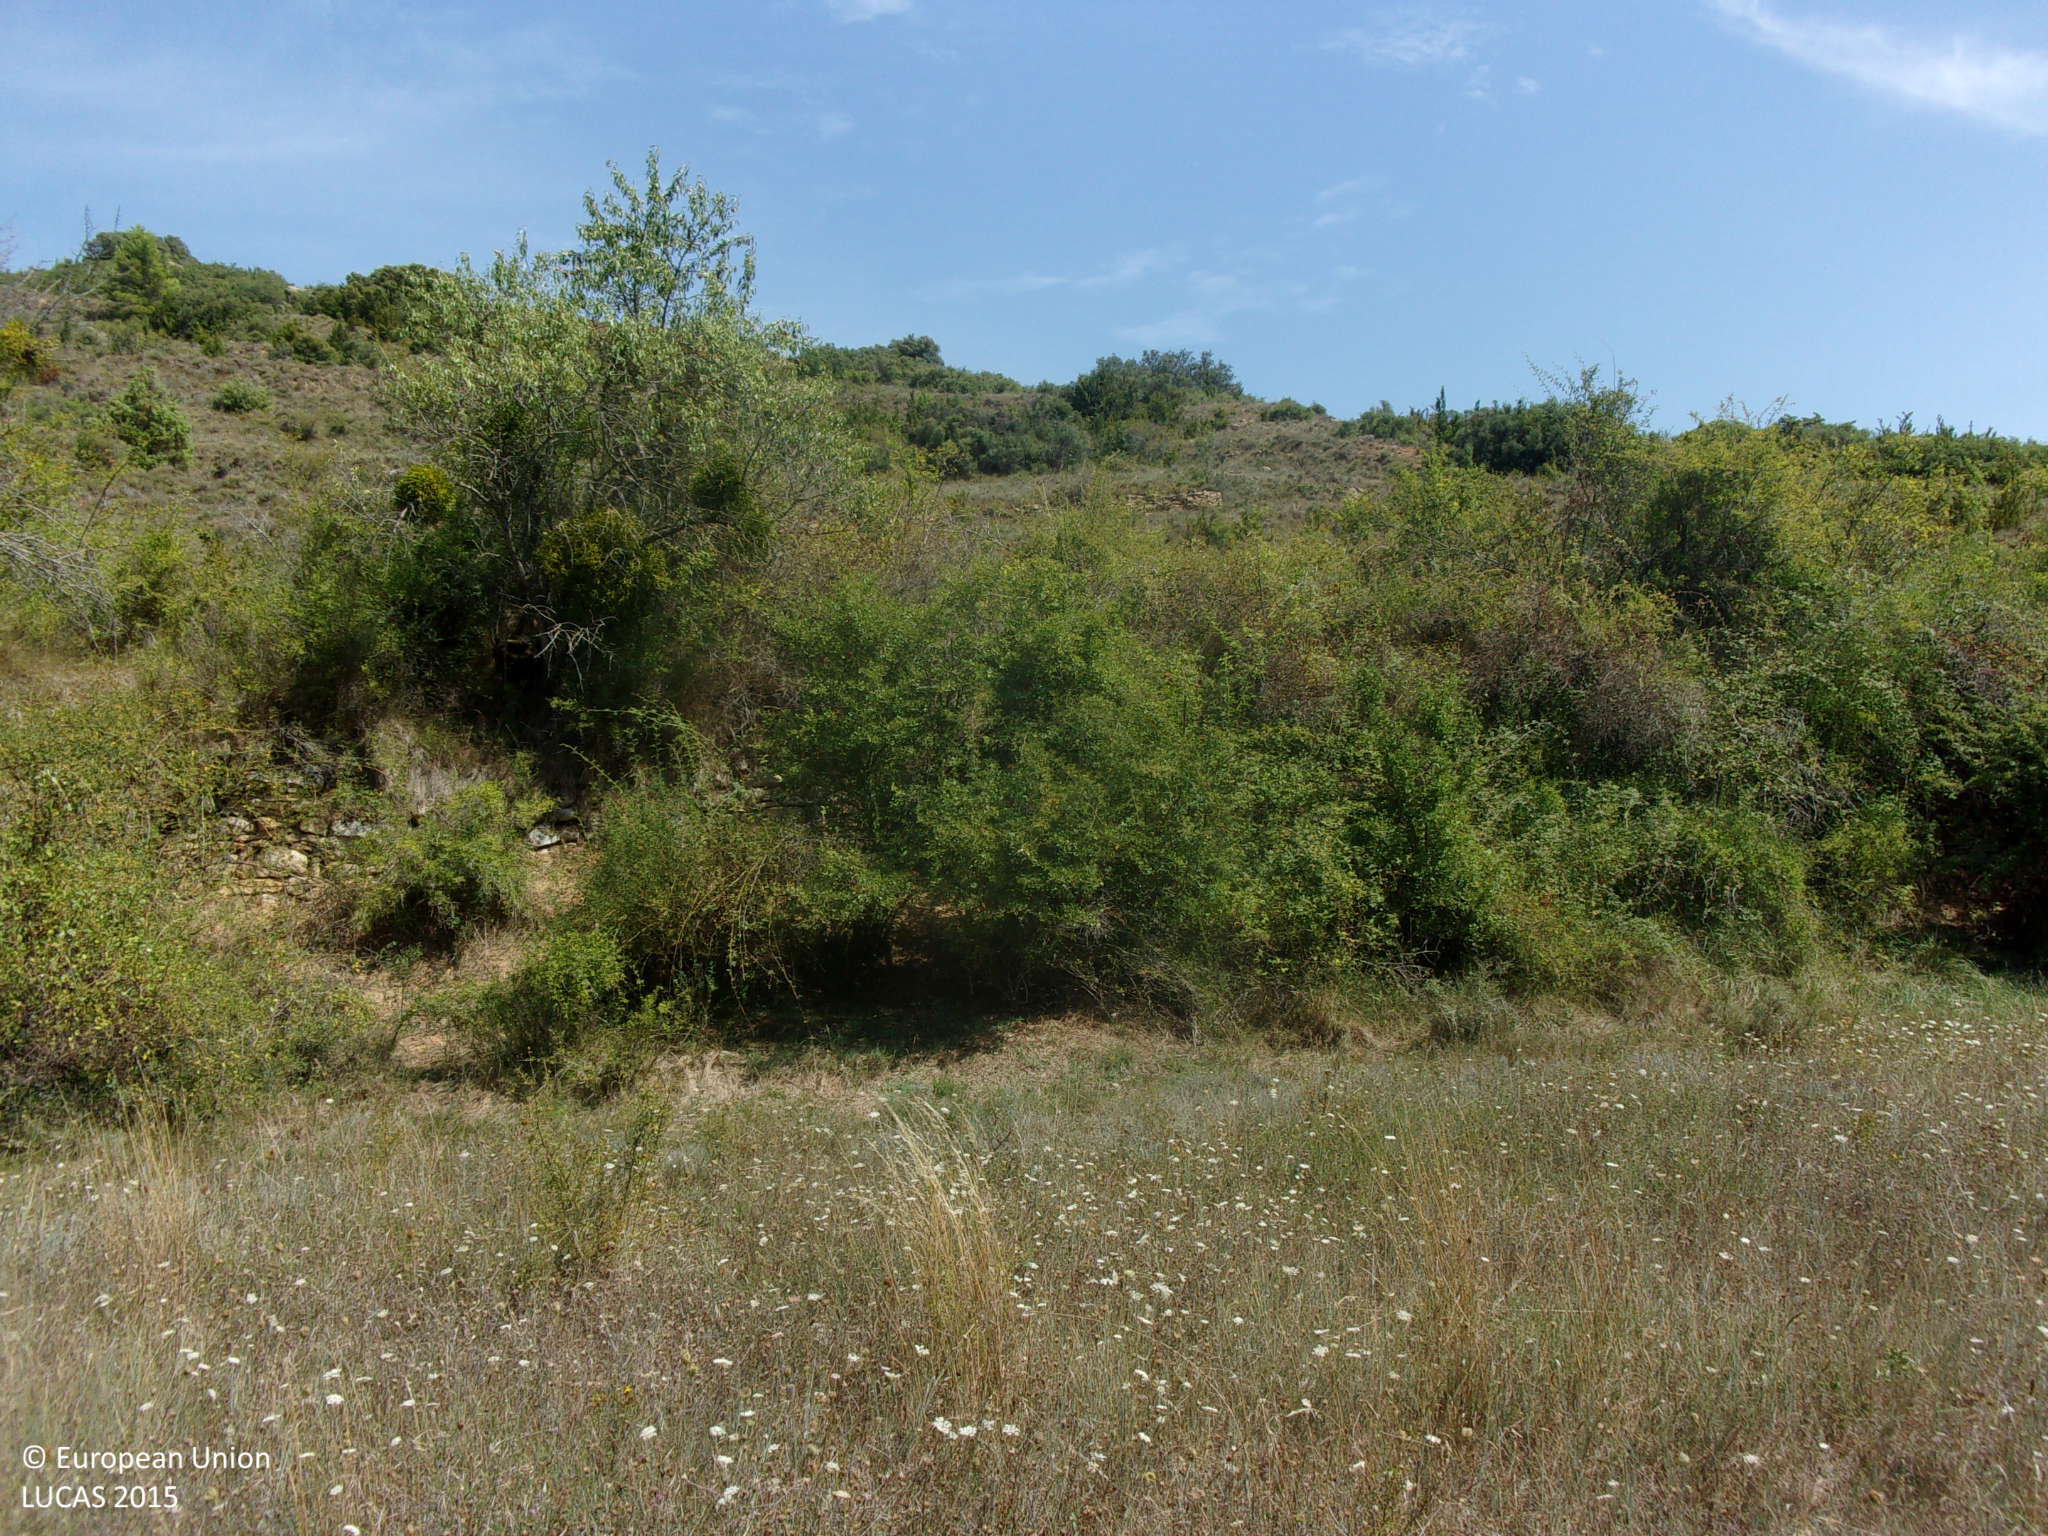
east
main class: Grassland
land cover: Spontaneously vegetated surfaces
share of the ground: > 75 %
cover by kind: herbaceous plants 100 %
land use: Abandoned areas
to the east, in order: Spontaneously vegetated surfaces; Shrubland with sparse tree cover; Broadleaved woodland; Shrubland with sparse tree cover
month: August
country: ES
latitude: 42.4848
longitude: -1.2122
